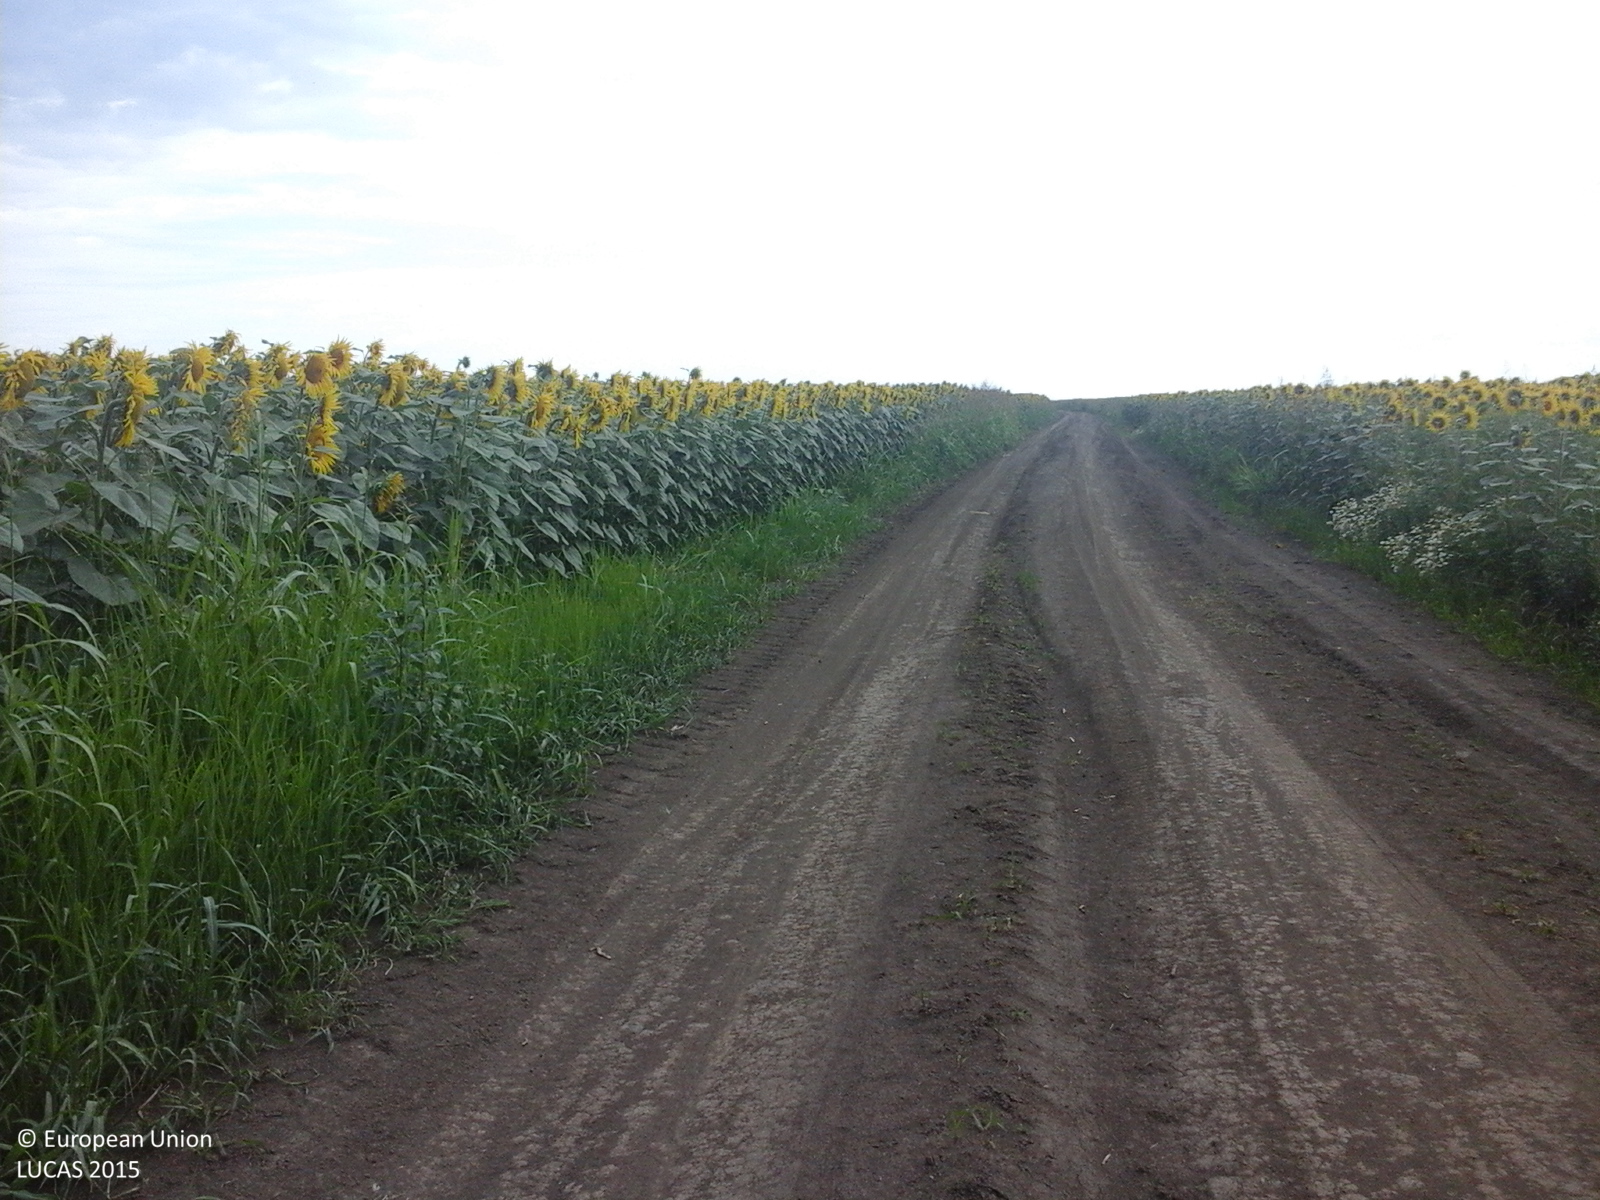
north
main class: Cropland
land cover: Sunflower
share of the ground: > 75 %
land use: Agriculture (excluding fallow land and kitchen gardens)
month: July
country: RO
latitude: 43.8012
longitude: 25.2559
